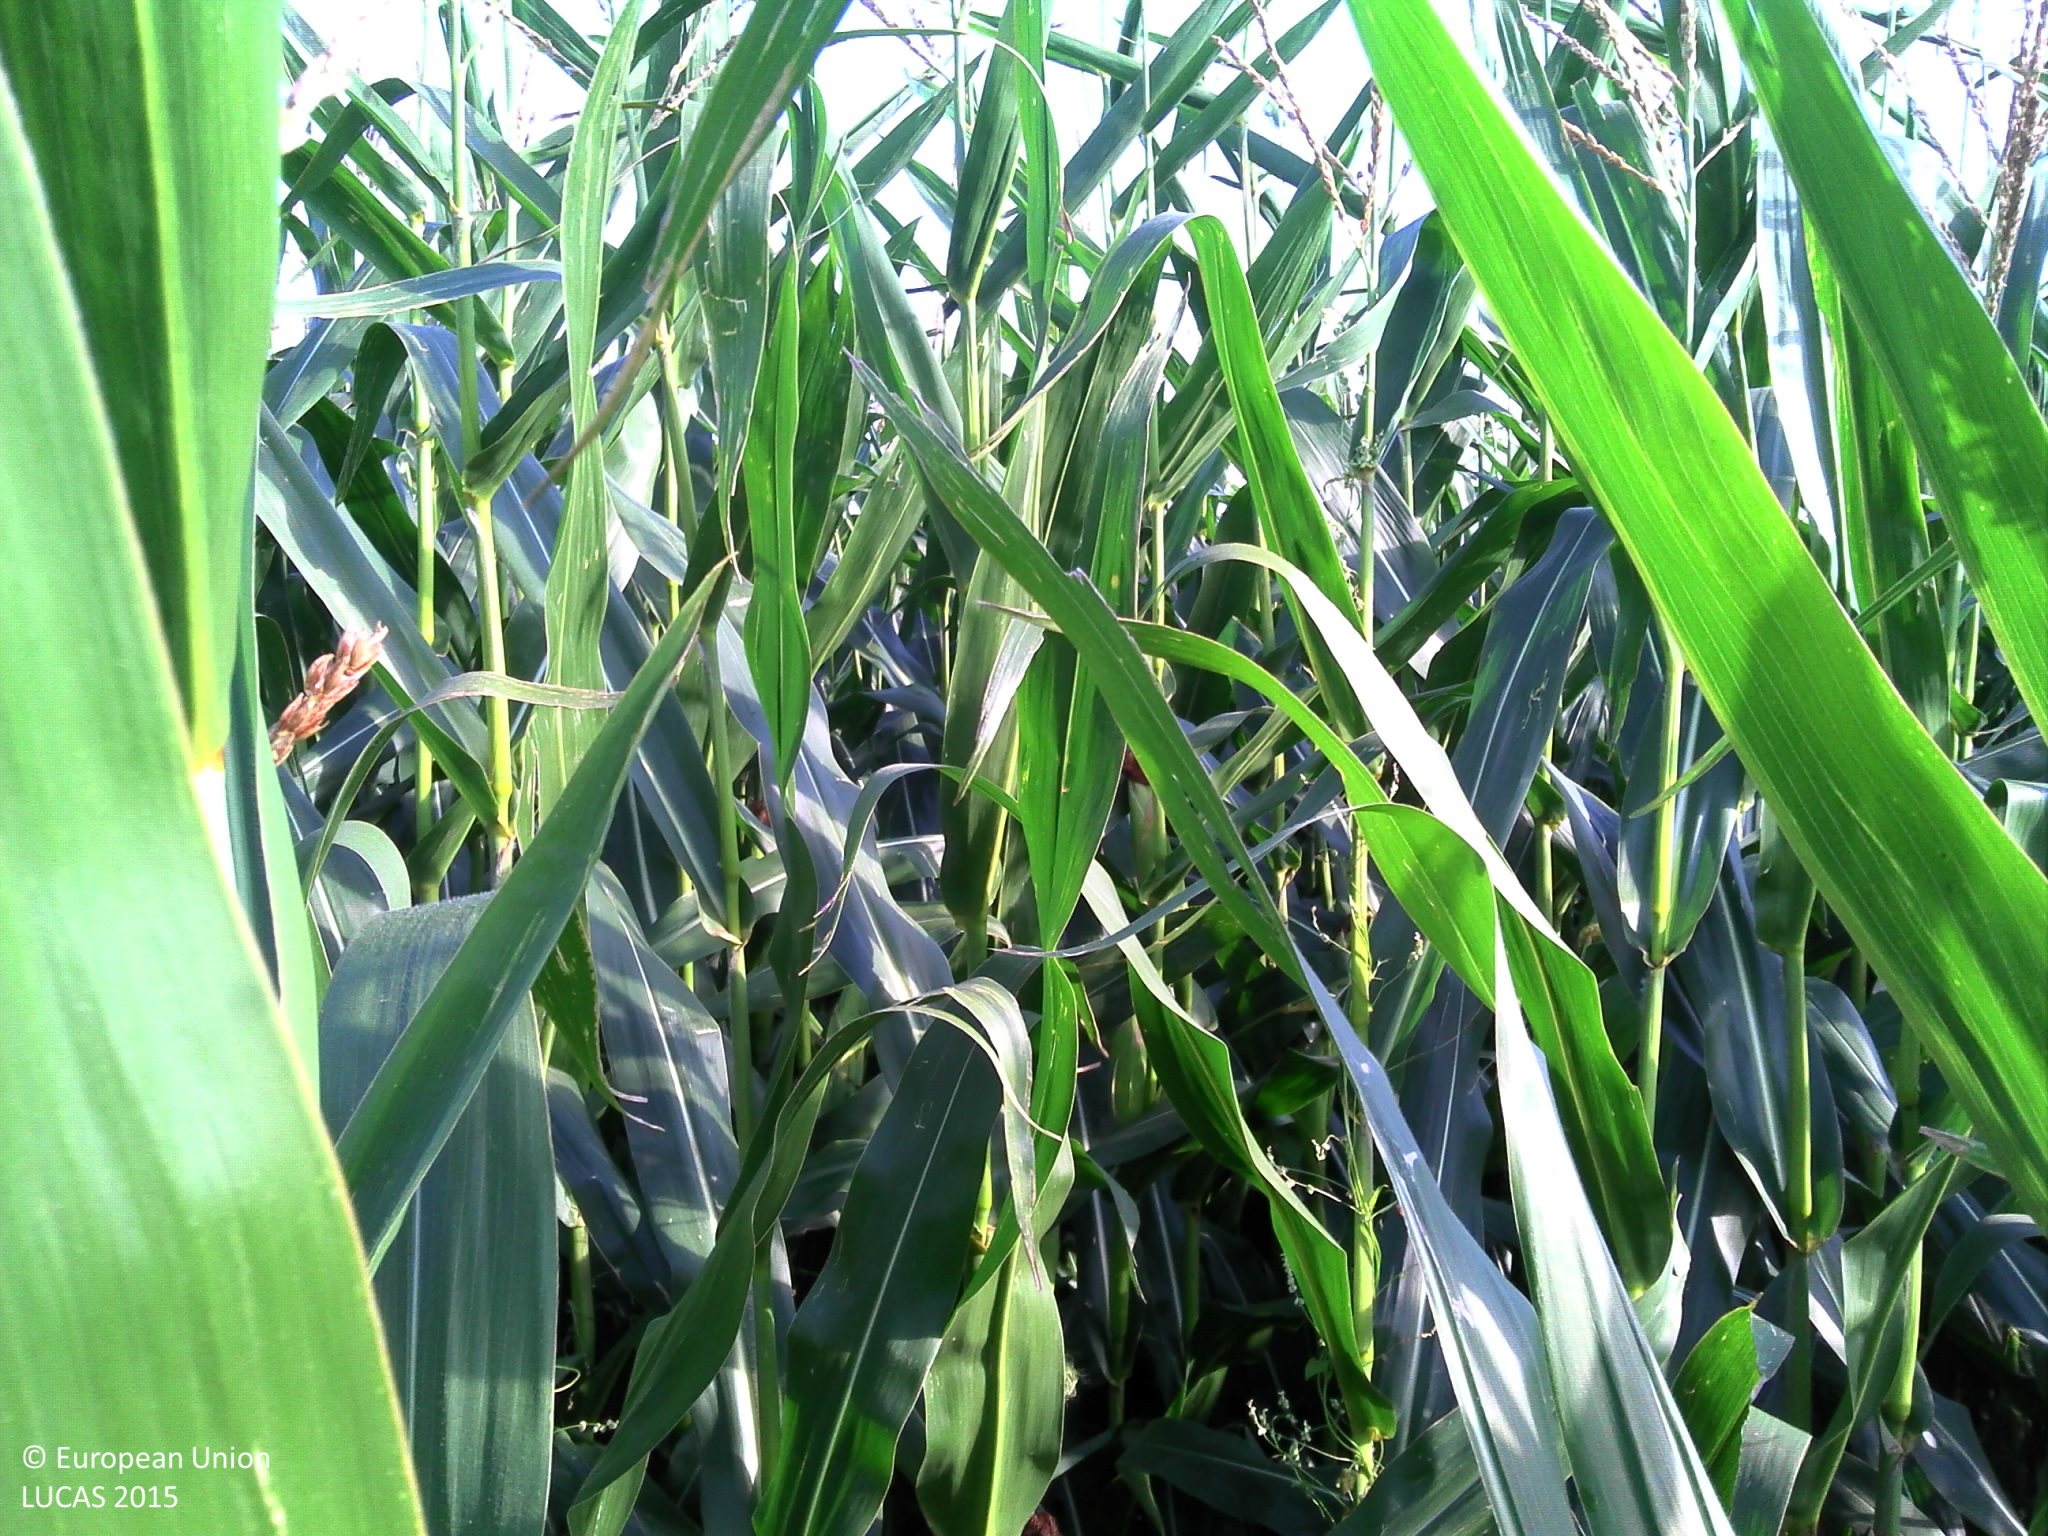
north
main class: Cropland
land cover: Maize
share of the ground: > 75 %
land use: Agriculture (excluding fallow land and kitchen gardens)
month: September
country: BE
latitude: 50.9977
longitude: 2.7071
